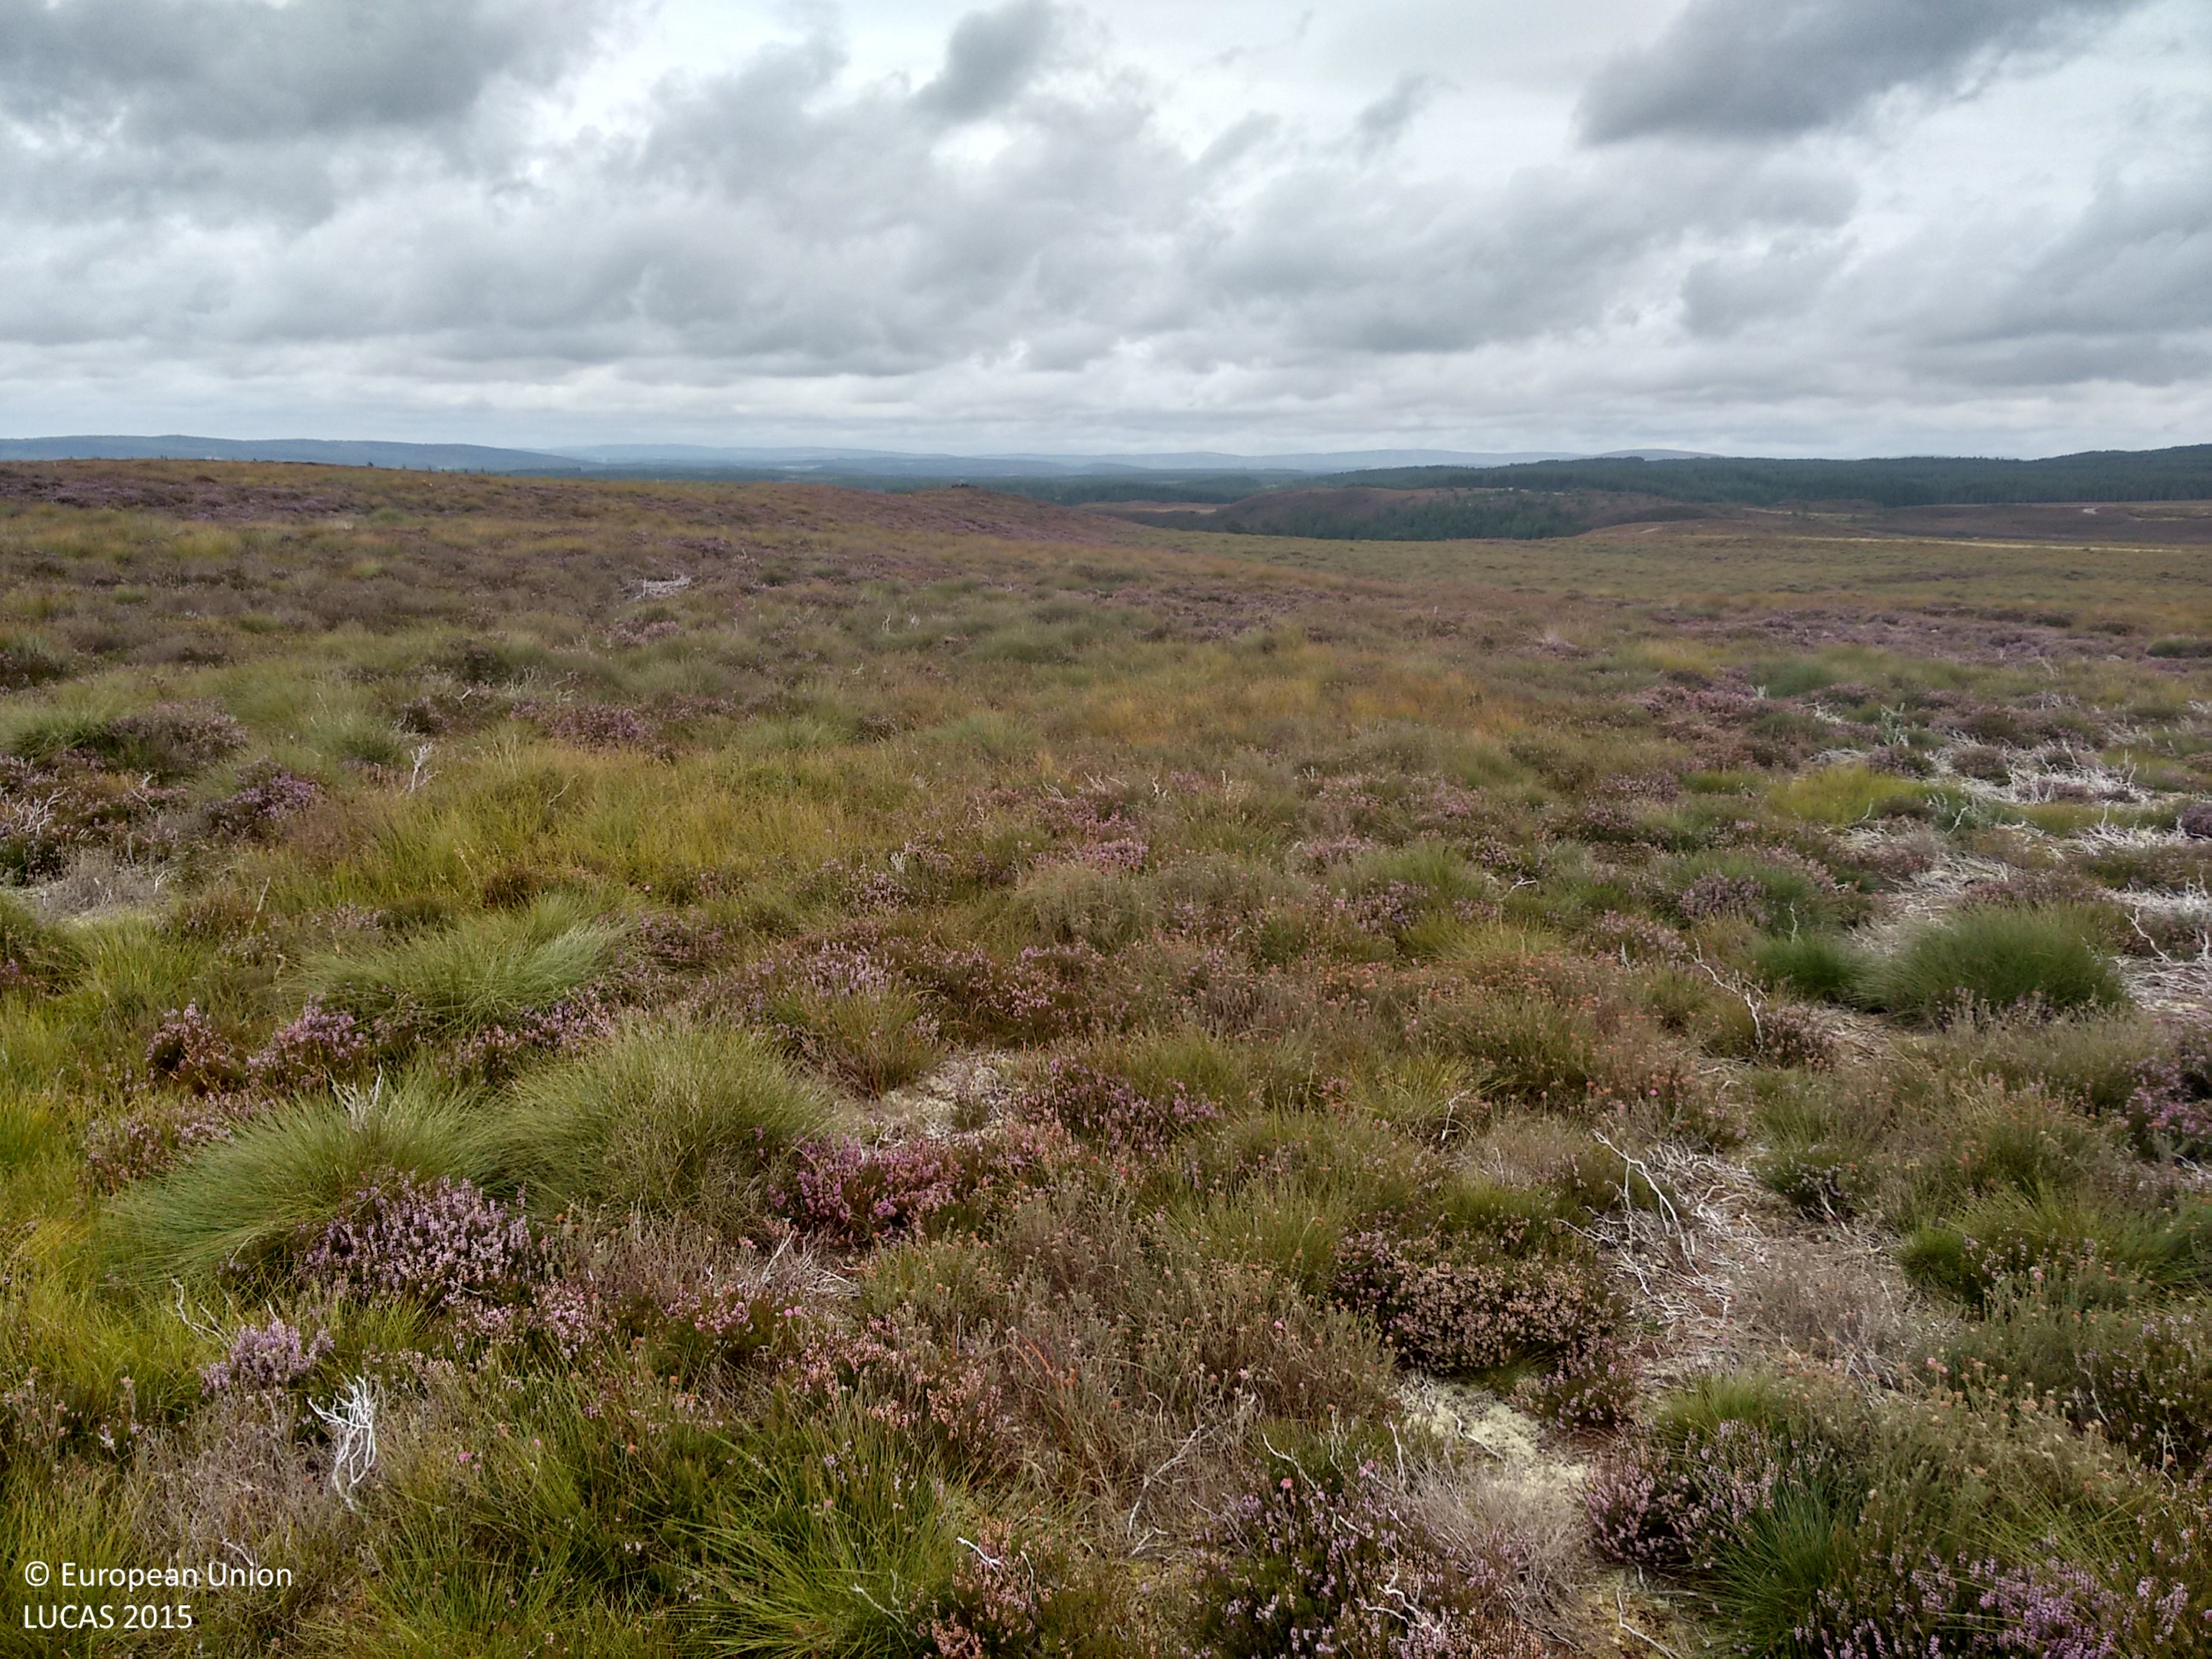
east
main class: Shrubland
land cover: Shrubland without tree cover
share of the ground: > 75 %
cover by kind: shrubs 80 %, herbaceous plants 15 %, lichens and mosses 5 %
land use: Agriculture (excluding fallow land and kitchen gardens)
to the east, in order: Shrubland without tree cover; Ditches and canals; Shrubland without tree cover; Ditches and canals; Shrubland without tree cover
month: September
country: GB
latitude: 57.4772
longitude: -3.8695
